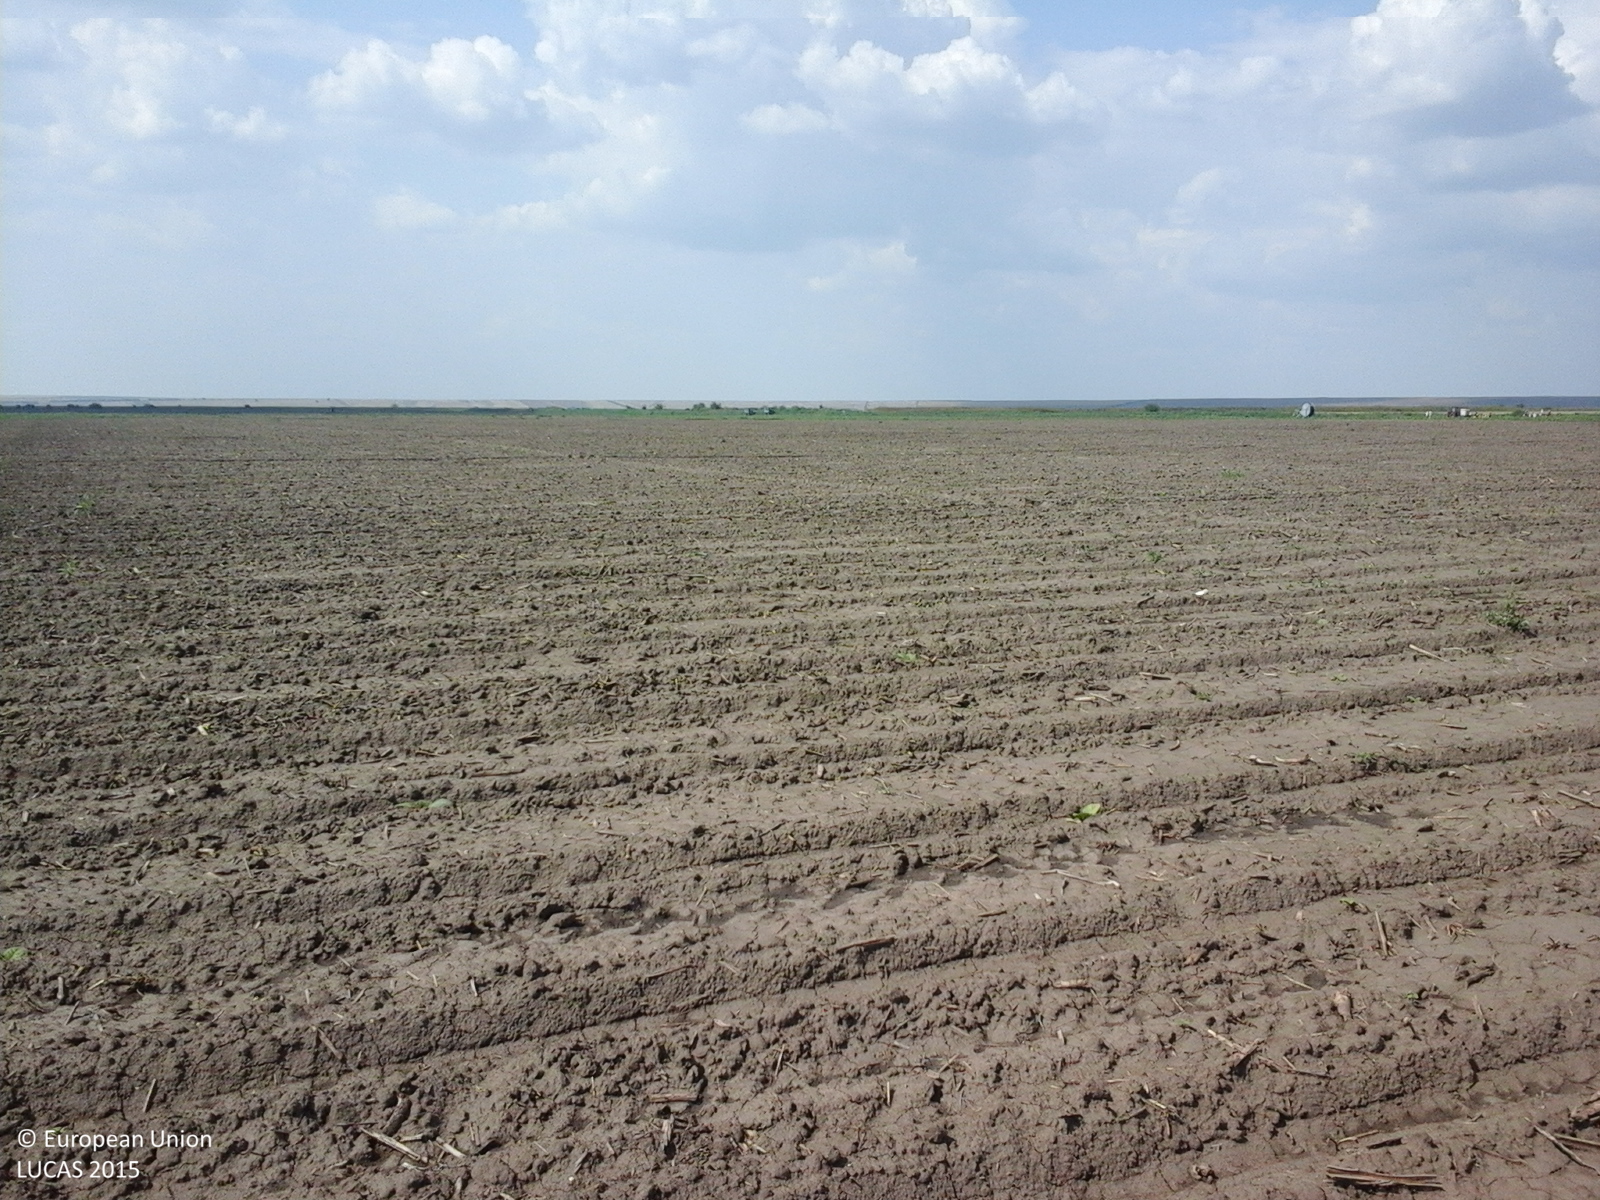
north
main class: Cropland
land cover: Tobacco
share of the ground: < 10 %
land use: Agriculture (excluding fallow land and kitchen gardens)
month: July
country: RO
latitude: 43.6837
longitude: 25.4271
